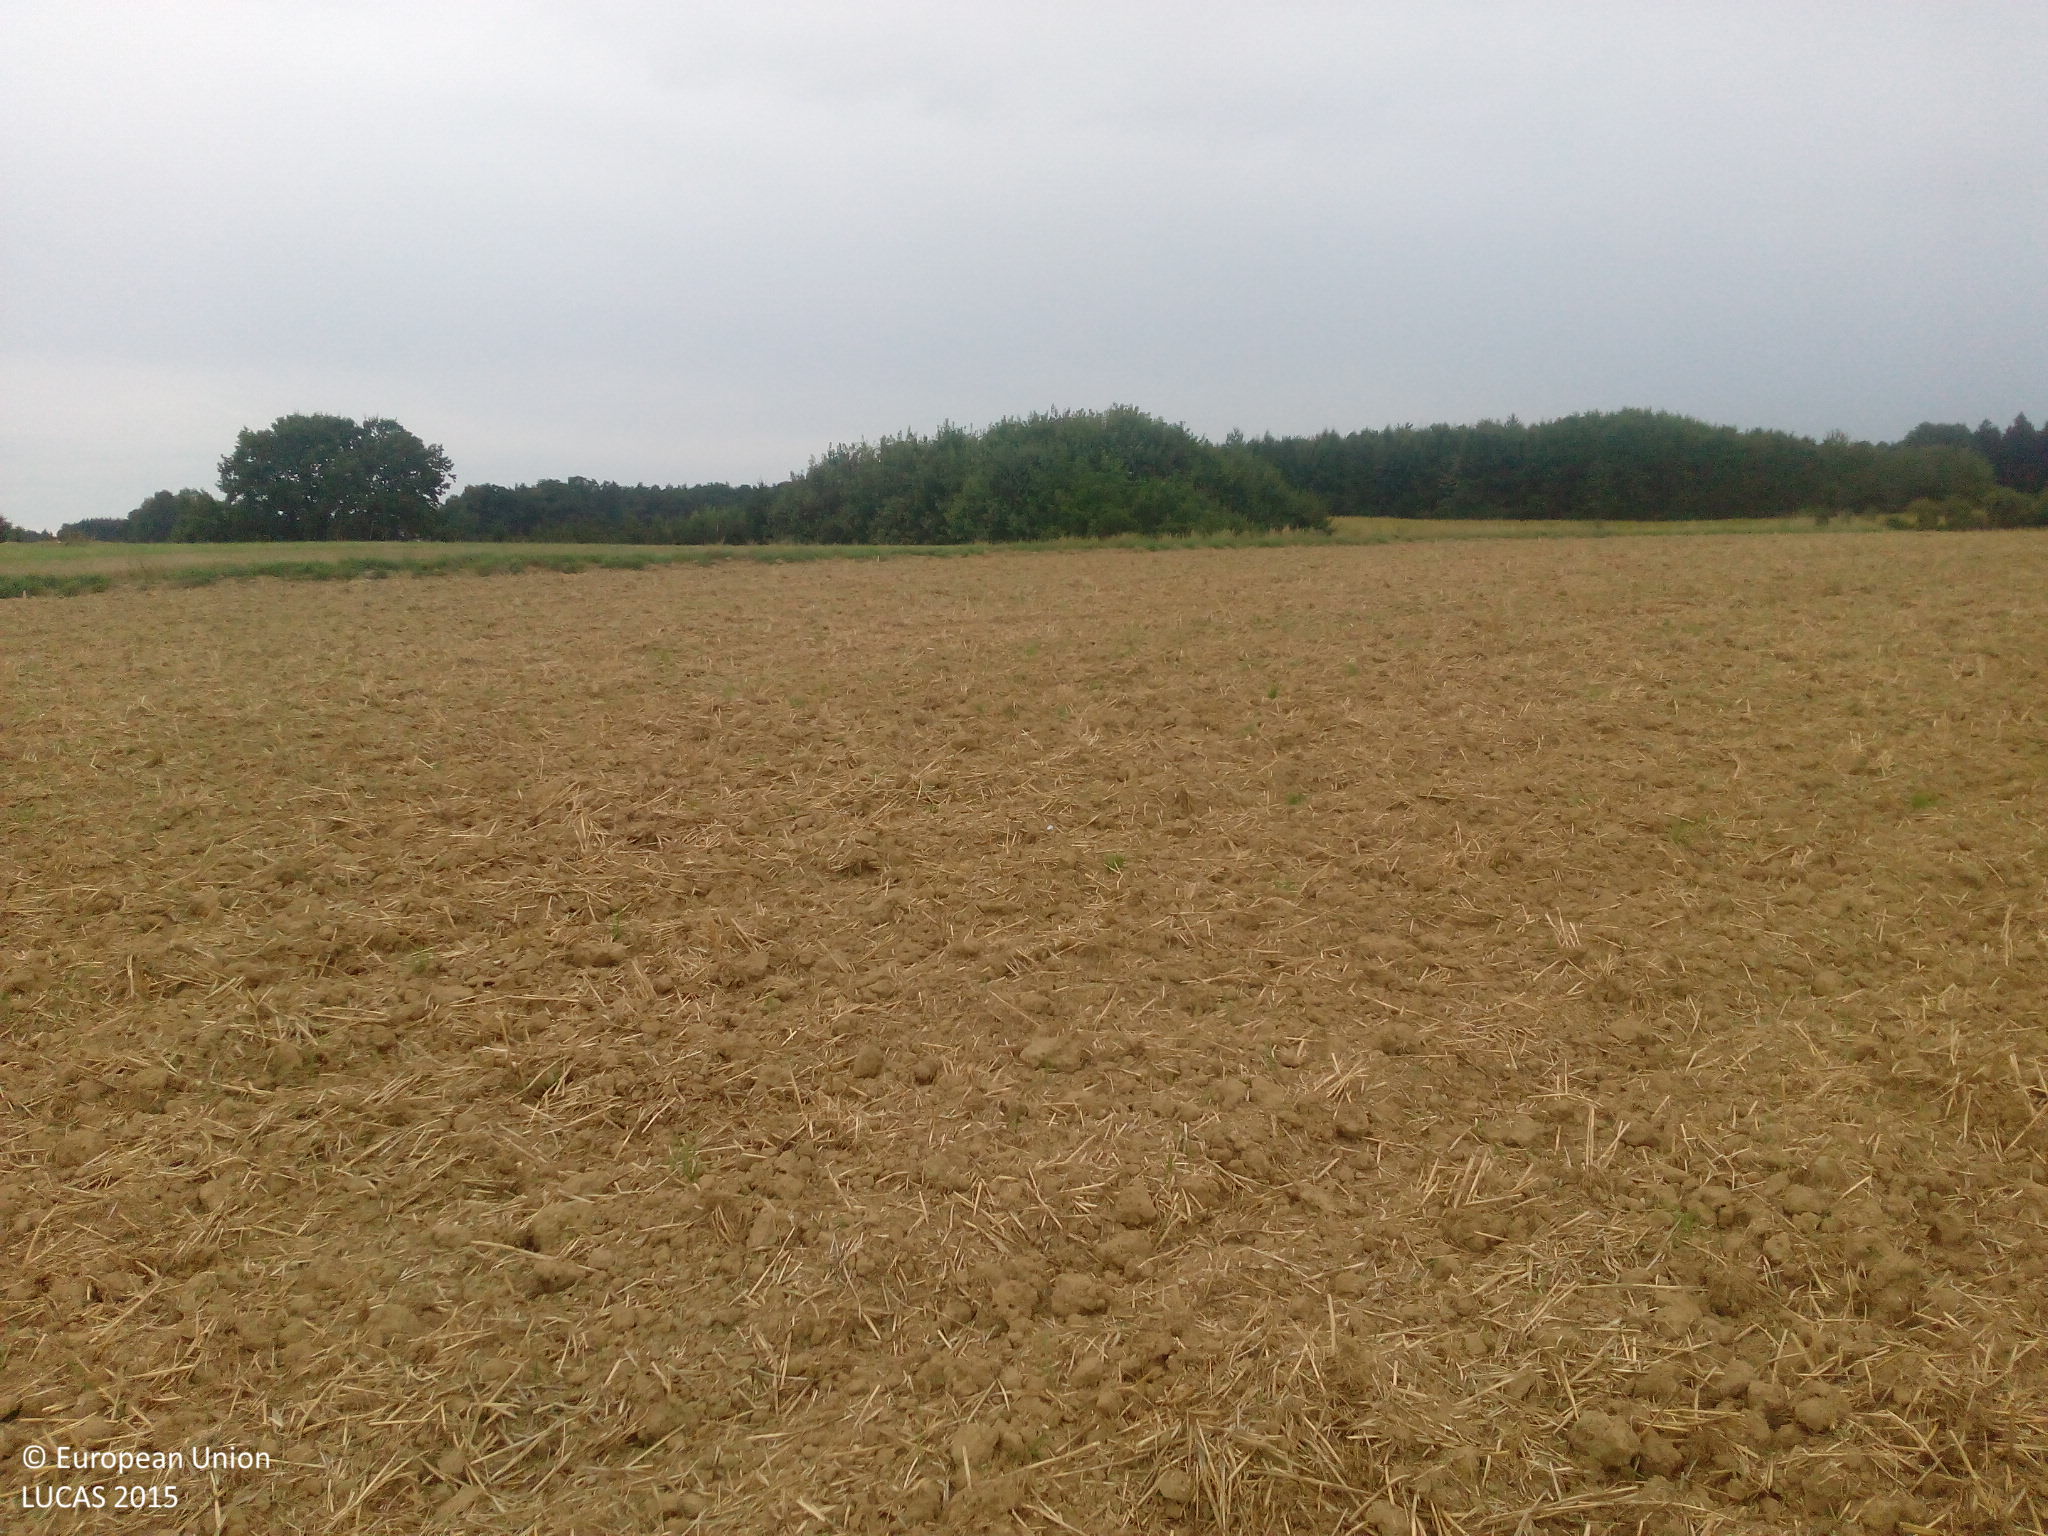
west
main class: Cropland
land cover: Common wheat
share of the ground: < 10 %
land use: Agriculture (excluding fallow land and kitchen gardens)
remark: Harvested field
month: September
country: DE
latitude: 48.4477
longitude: 11.4729
